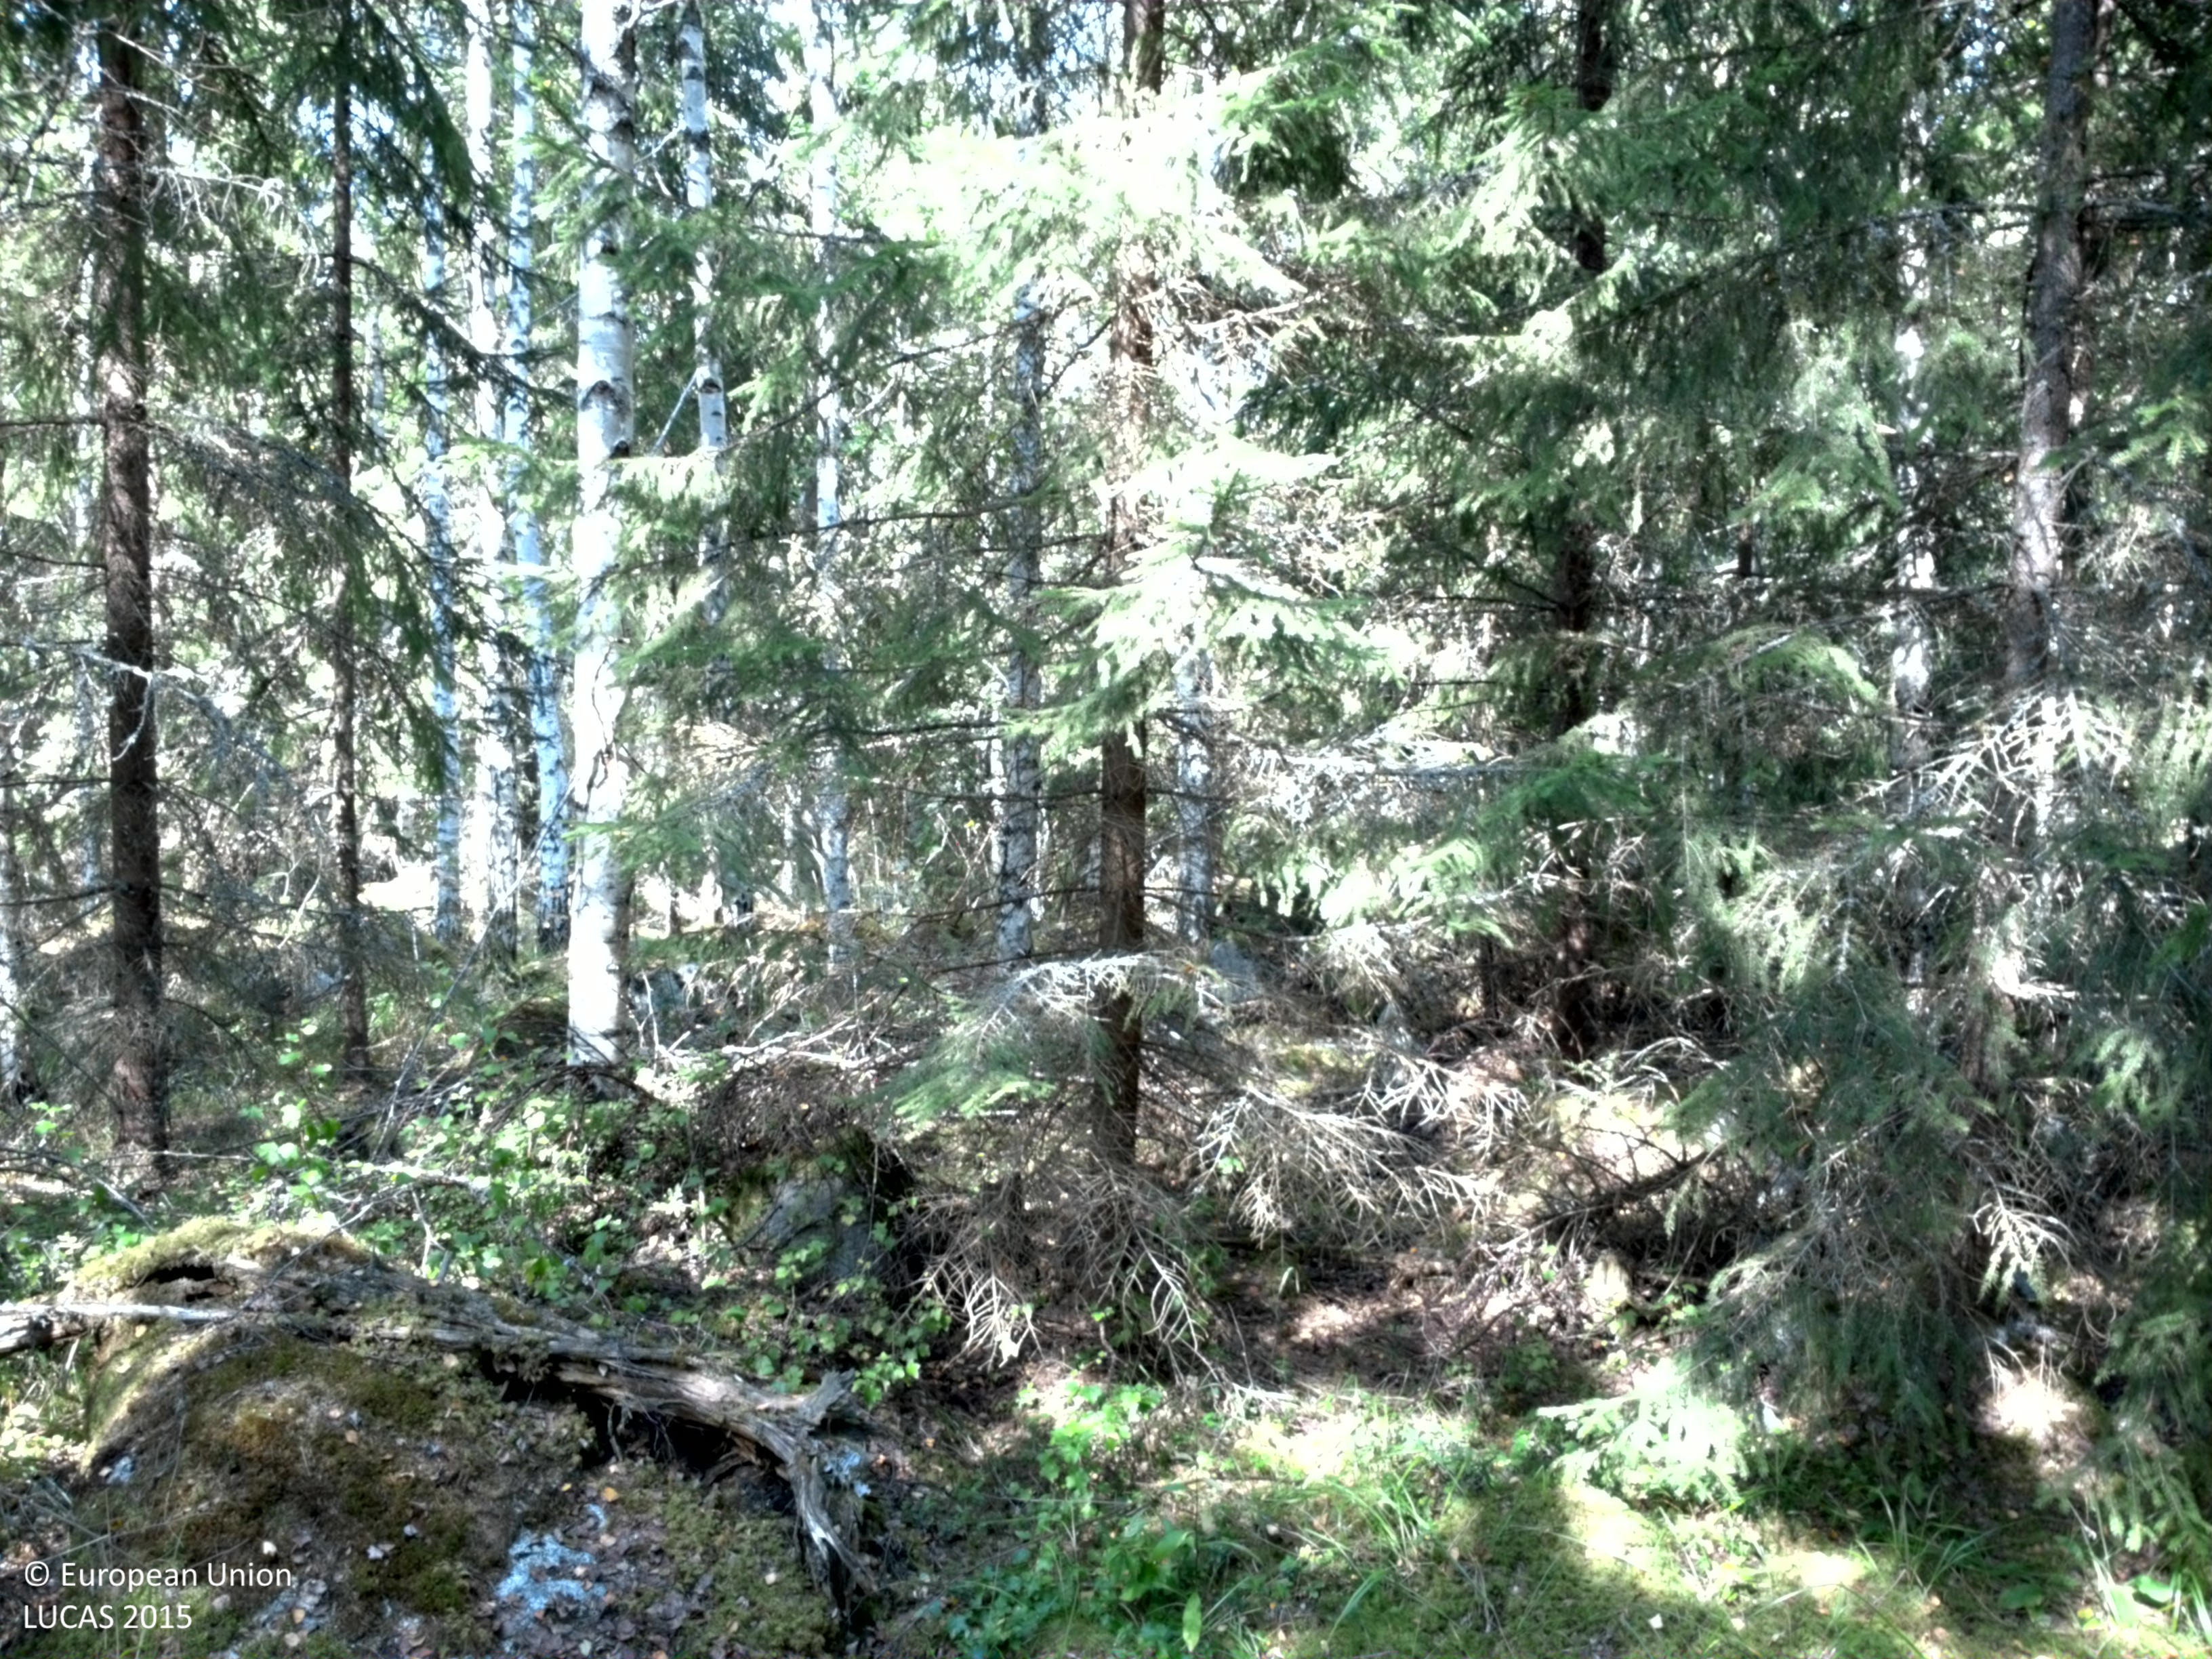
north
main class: Woodland
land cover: Spruce dominated coniferous woodland
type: boreal forest
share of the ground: > 75 %
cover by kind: coniferous forest trees 80 %, lichens and mosses 20 %
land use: Forestry
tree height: > 5 m
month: August
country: SE
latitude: 60.1123
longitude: 17.7478
